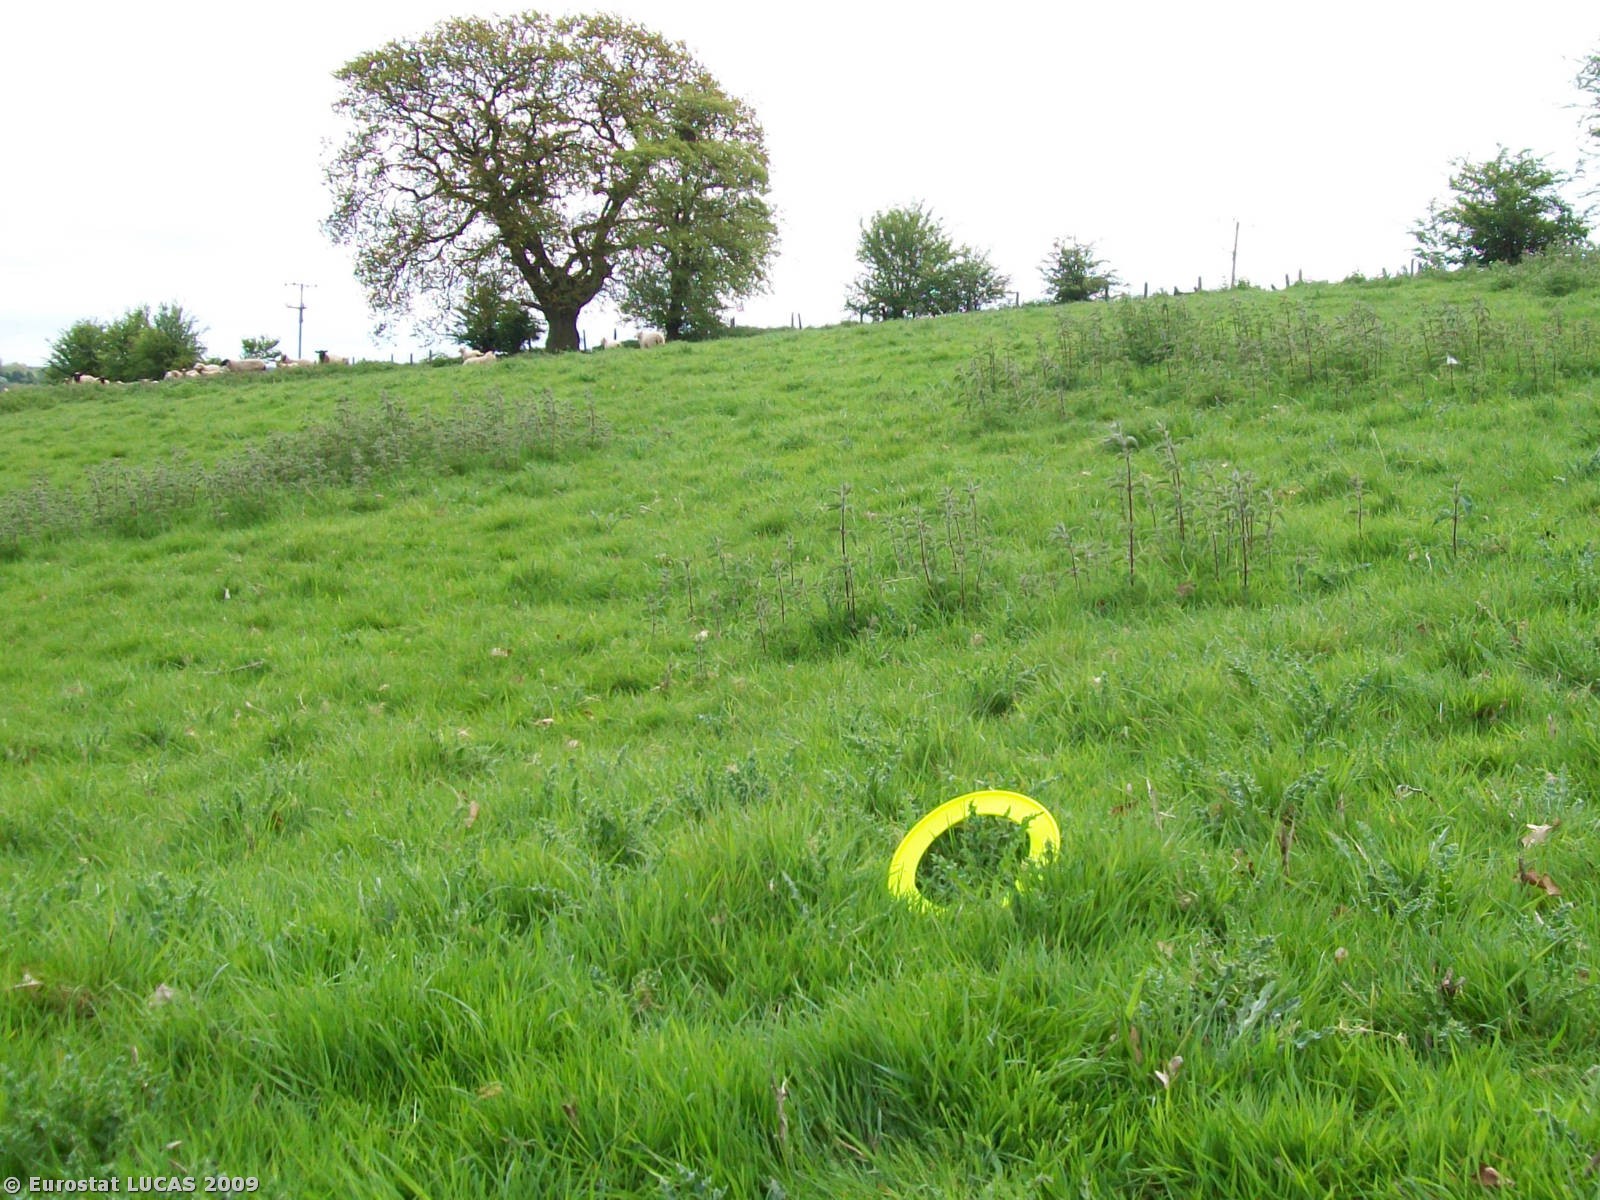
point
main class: Grassland
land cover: Grassland without tree/shrub cover
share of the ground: > 75 %
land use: Agriculture (excluding fallow land and kitchen gardens)
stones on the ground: < 10 %
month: May
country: GB
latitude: 52.3712
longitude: -2.4772
